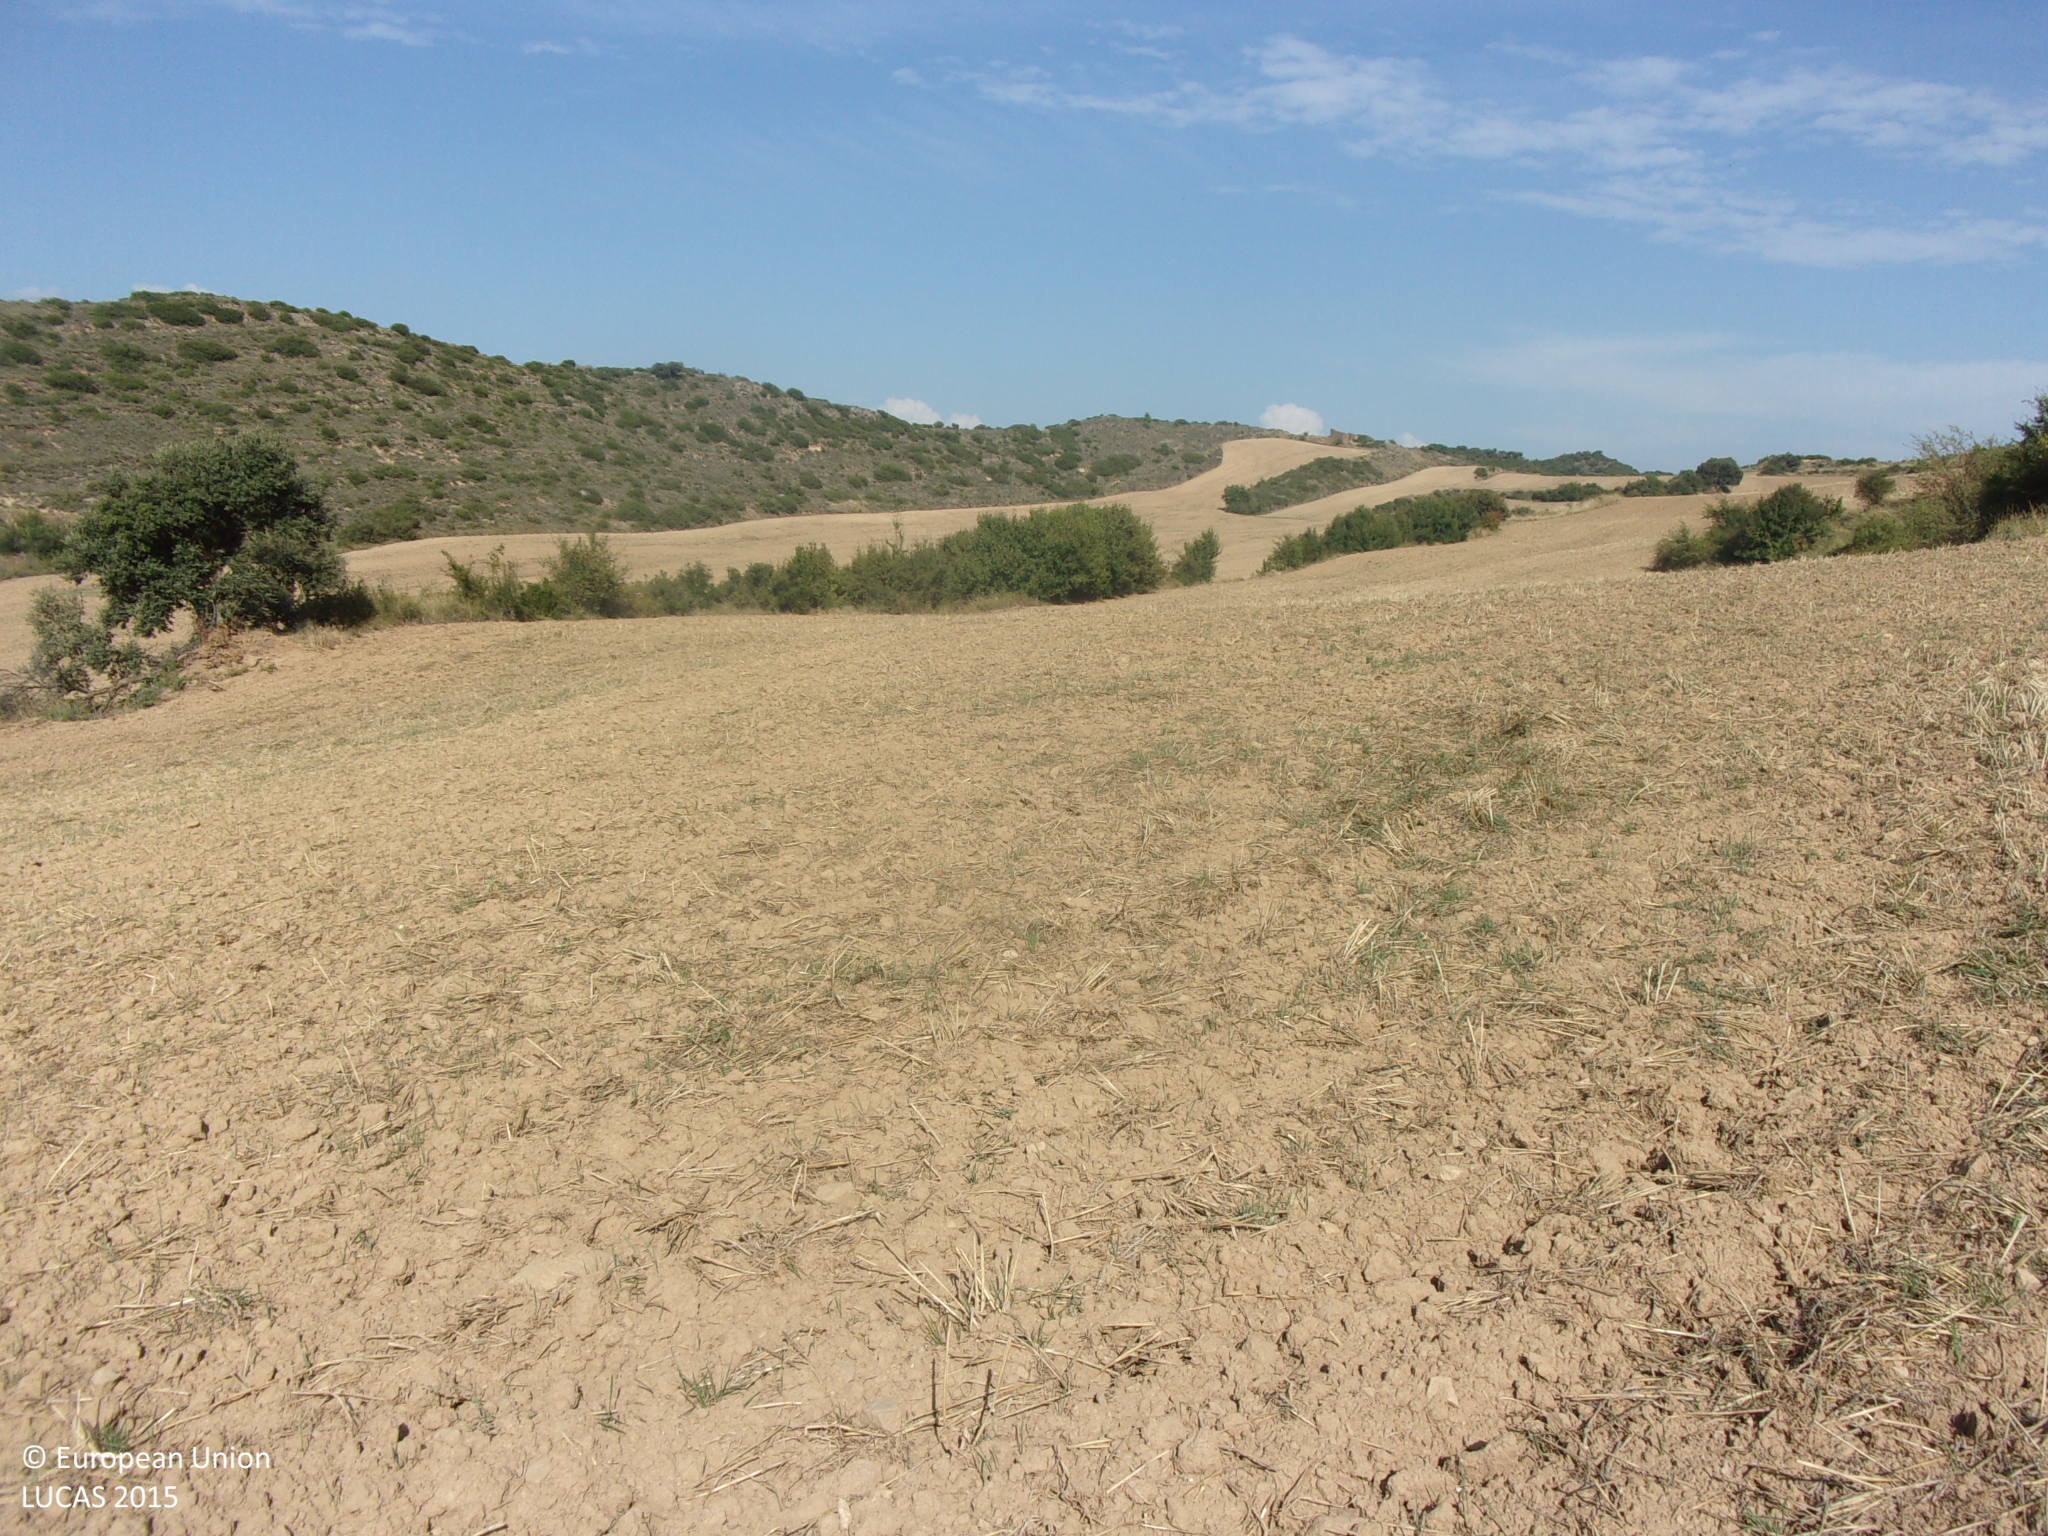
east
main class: Cropland
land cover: Common wheat
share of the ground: < 10 %
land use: Agriculture (excluding fallow land and kitchen gardens)
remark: Harvested field
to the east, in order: Common wheat; Shrubland with sparse tree cover; Common wheat
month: August
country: ES
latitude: 42.5053
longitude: -1.1915
